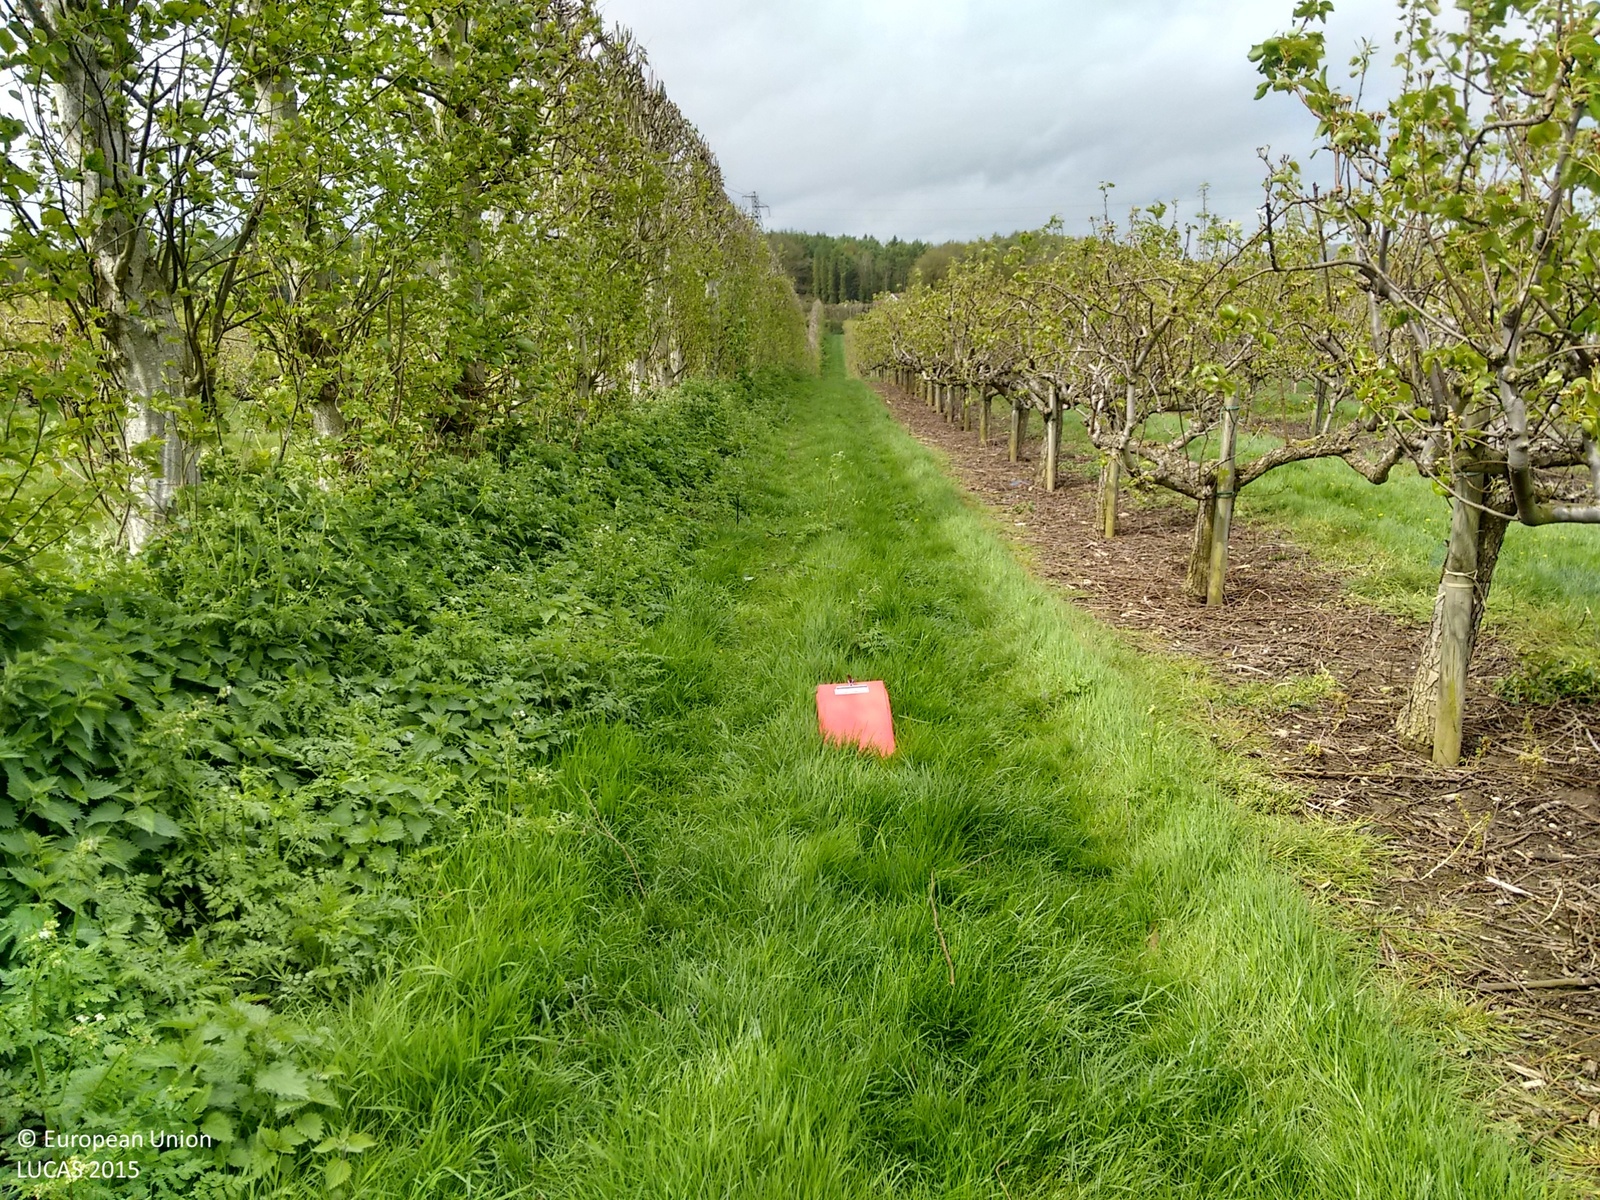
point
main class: Cropland
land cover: Pear fruit
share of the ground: 50 - 75 %
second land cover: Grassland without tree/shrub cover
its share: 50 - 75 %
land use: Agriculture (excluding fallow land and kitchen gardens)
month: May
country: GB
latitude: 51.2726
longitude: 0.2946
